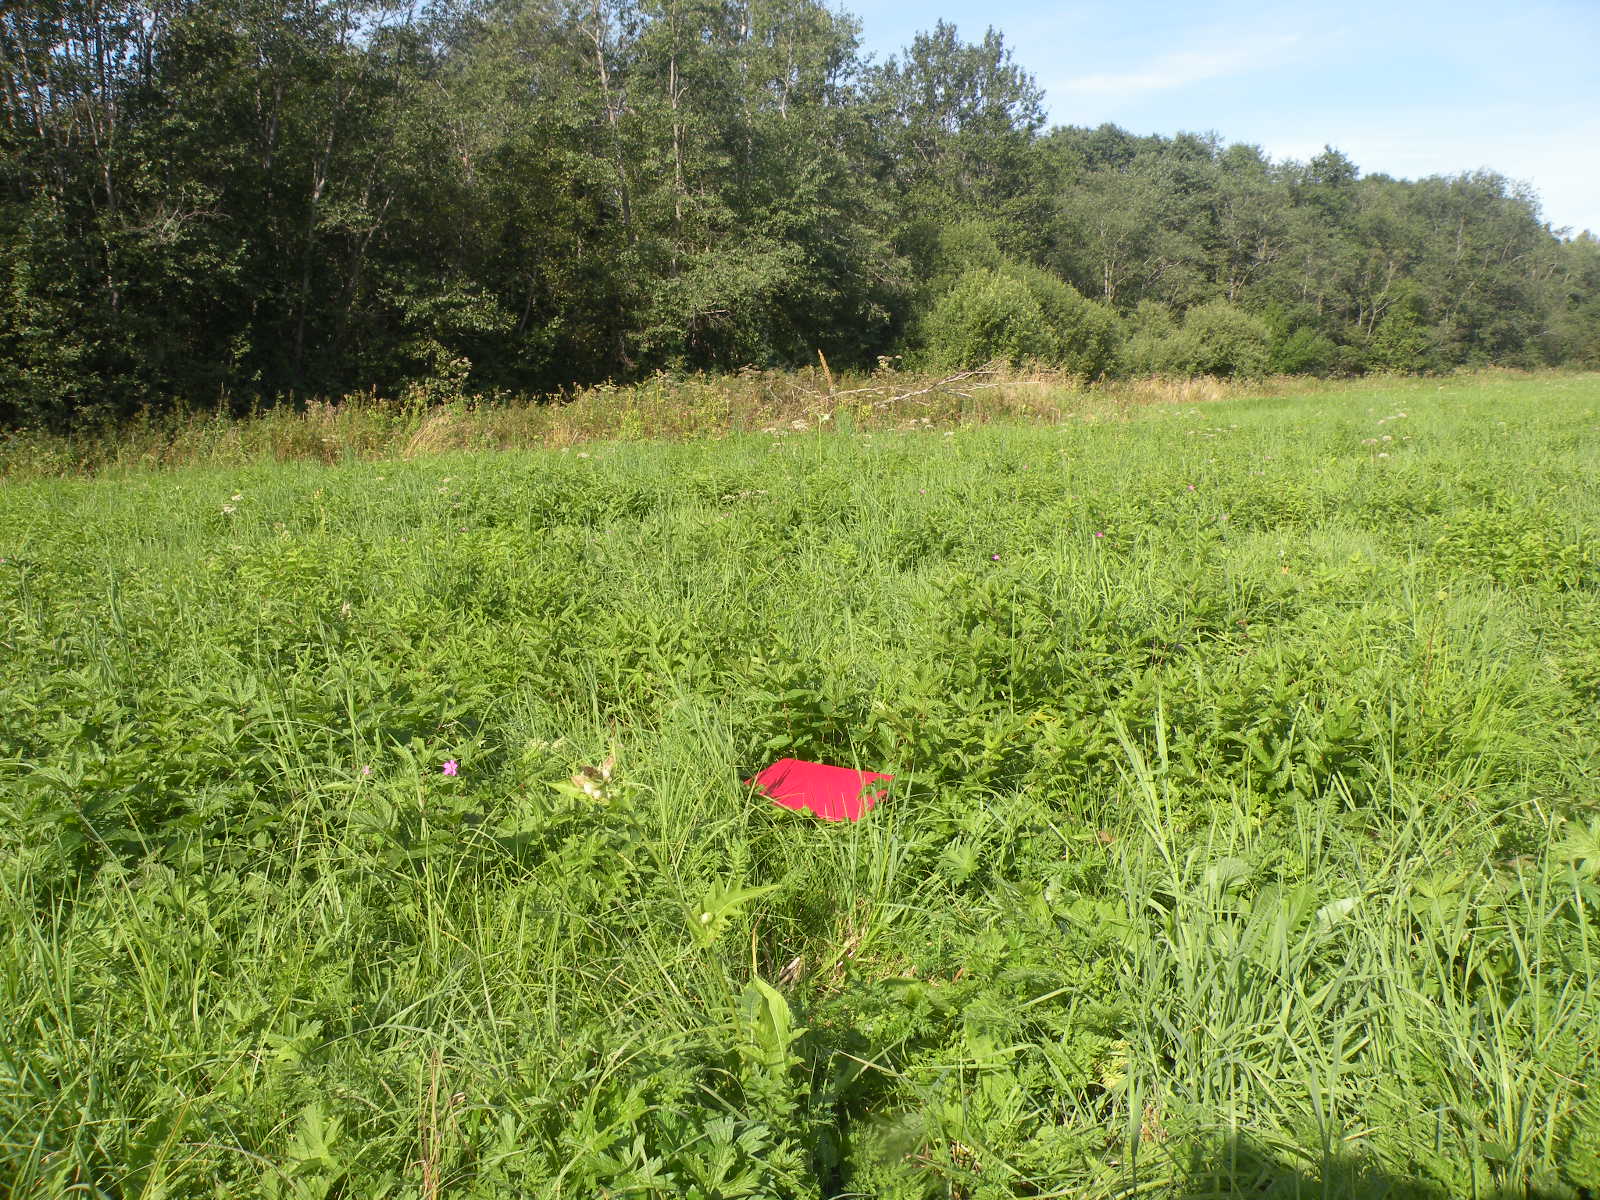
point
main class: Grassland
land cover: Grassland without tree/shrub cover
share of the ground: > 75 %
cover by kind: herbaceous plants 100 %
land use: Agriculture (excluding fallow land and kitchen gardens)
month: August
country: LV
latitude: 55.9481
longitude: 26.2690
